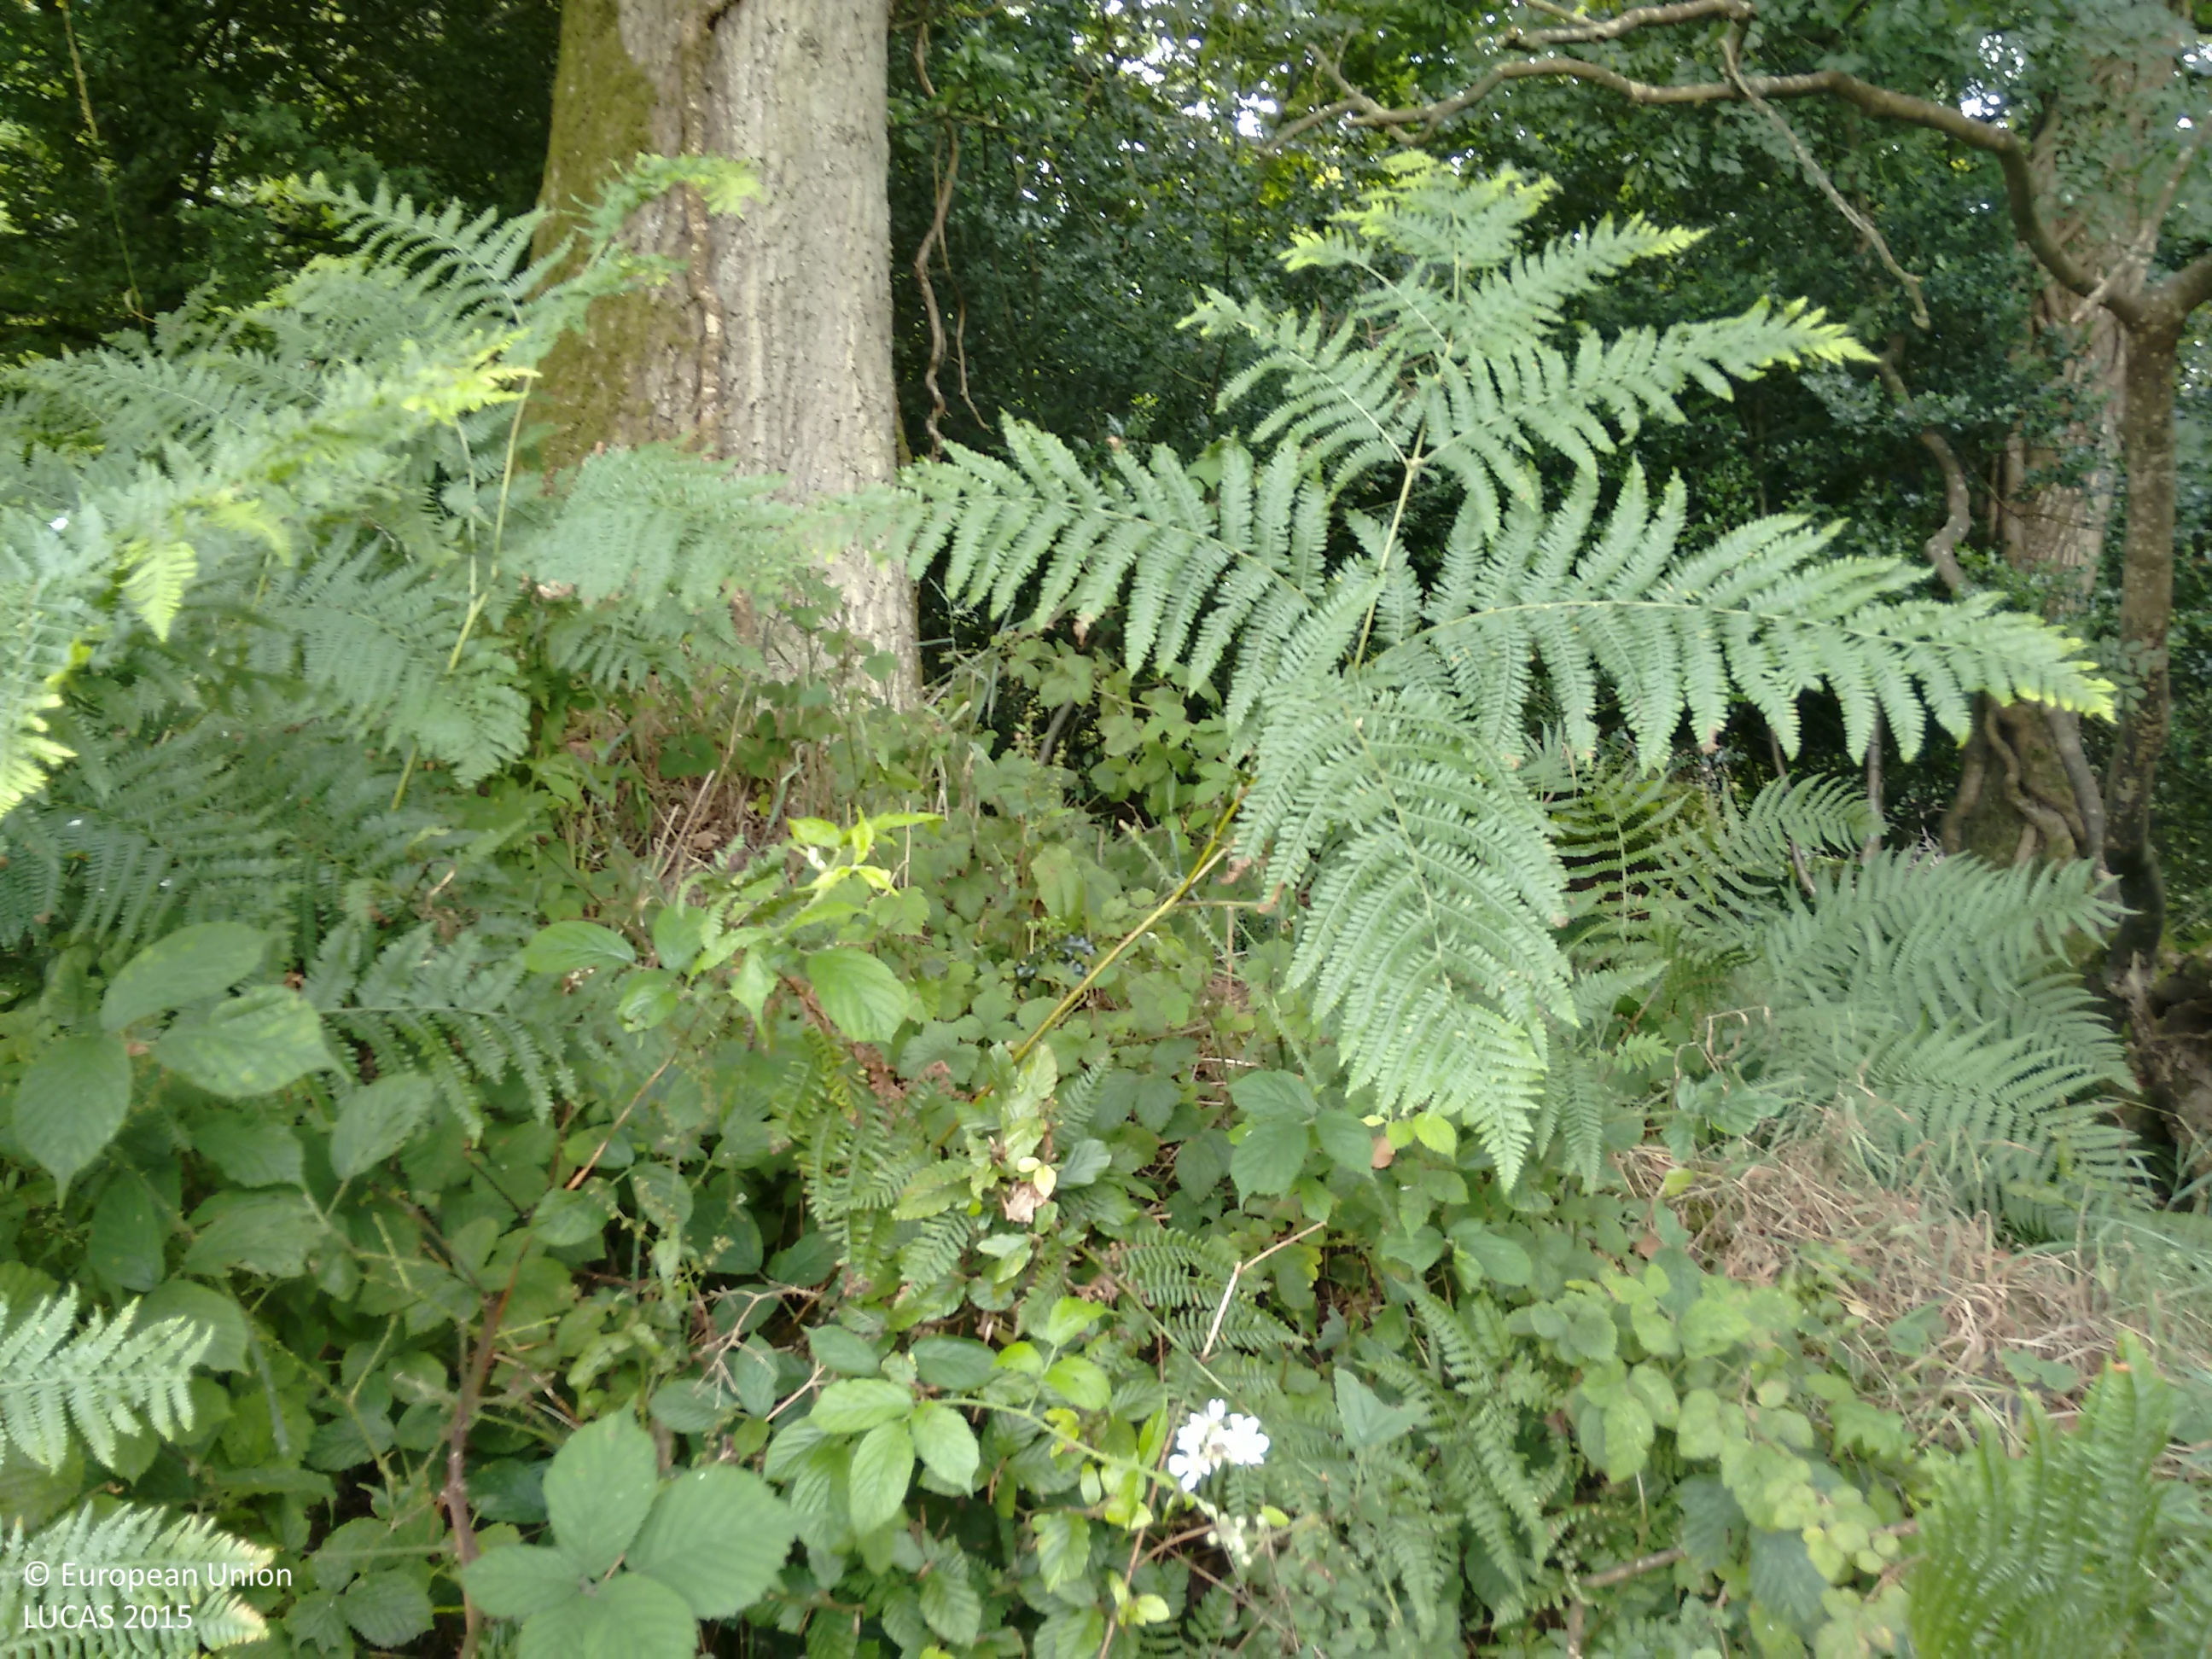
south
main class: Woodland
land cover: Broadleaved woodland
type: mesophytic deciduous forest
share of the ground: > 75 %
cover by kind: broadleaved forest trees 100 %
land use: Semi-natural and natural areas not in use
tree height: > 5 m
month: August
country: GB
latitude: 50.8739
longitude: -3.4849
